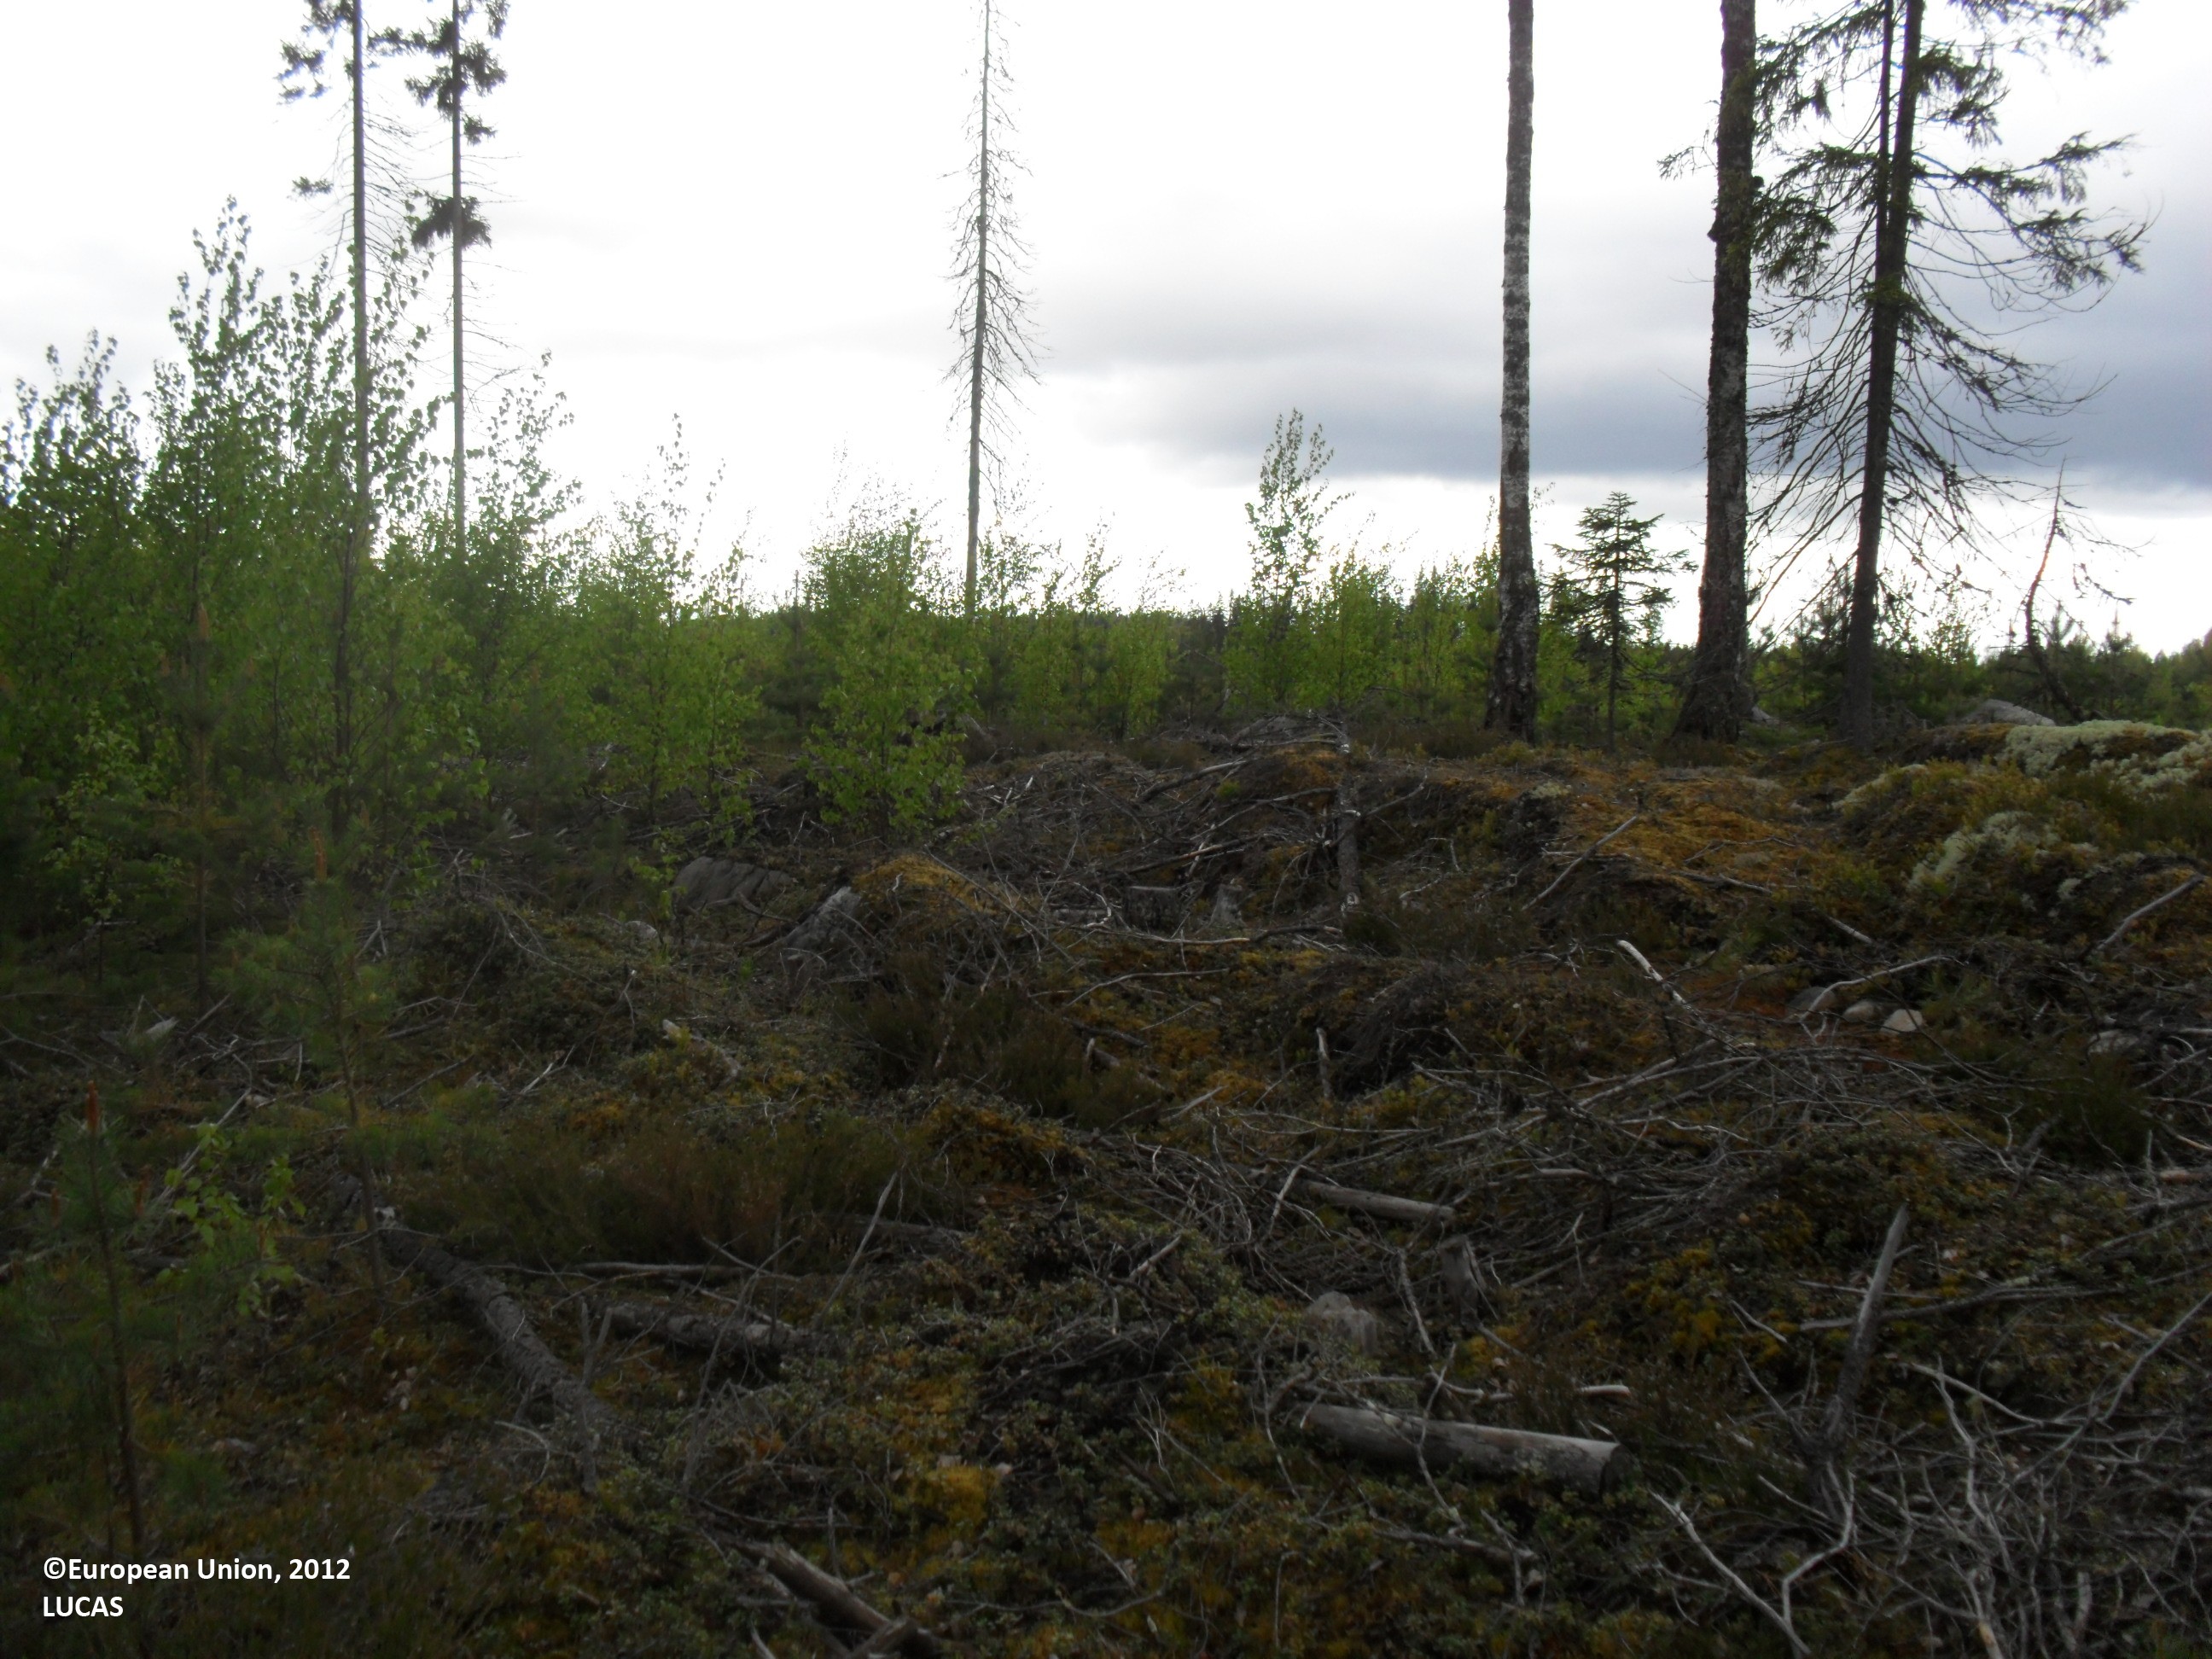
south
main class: Woodland
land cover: Pine dominated mixed woodland
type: boreal forest
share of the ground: < 10 %
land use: Forestry
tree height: < 5 m
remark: Clear cut
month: June
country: FI
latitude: 62.9156
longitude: 23.1136
